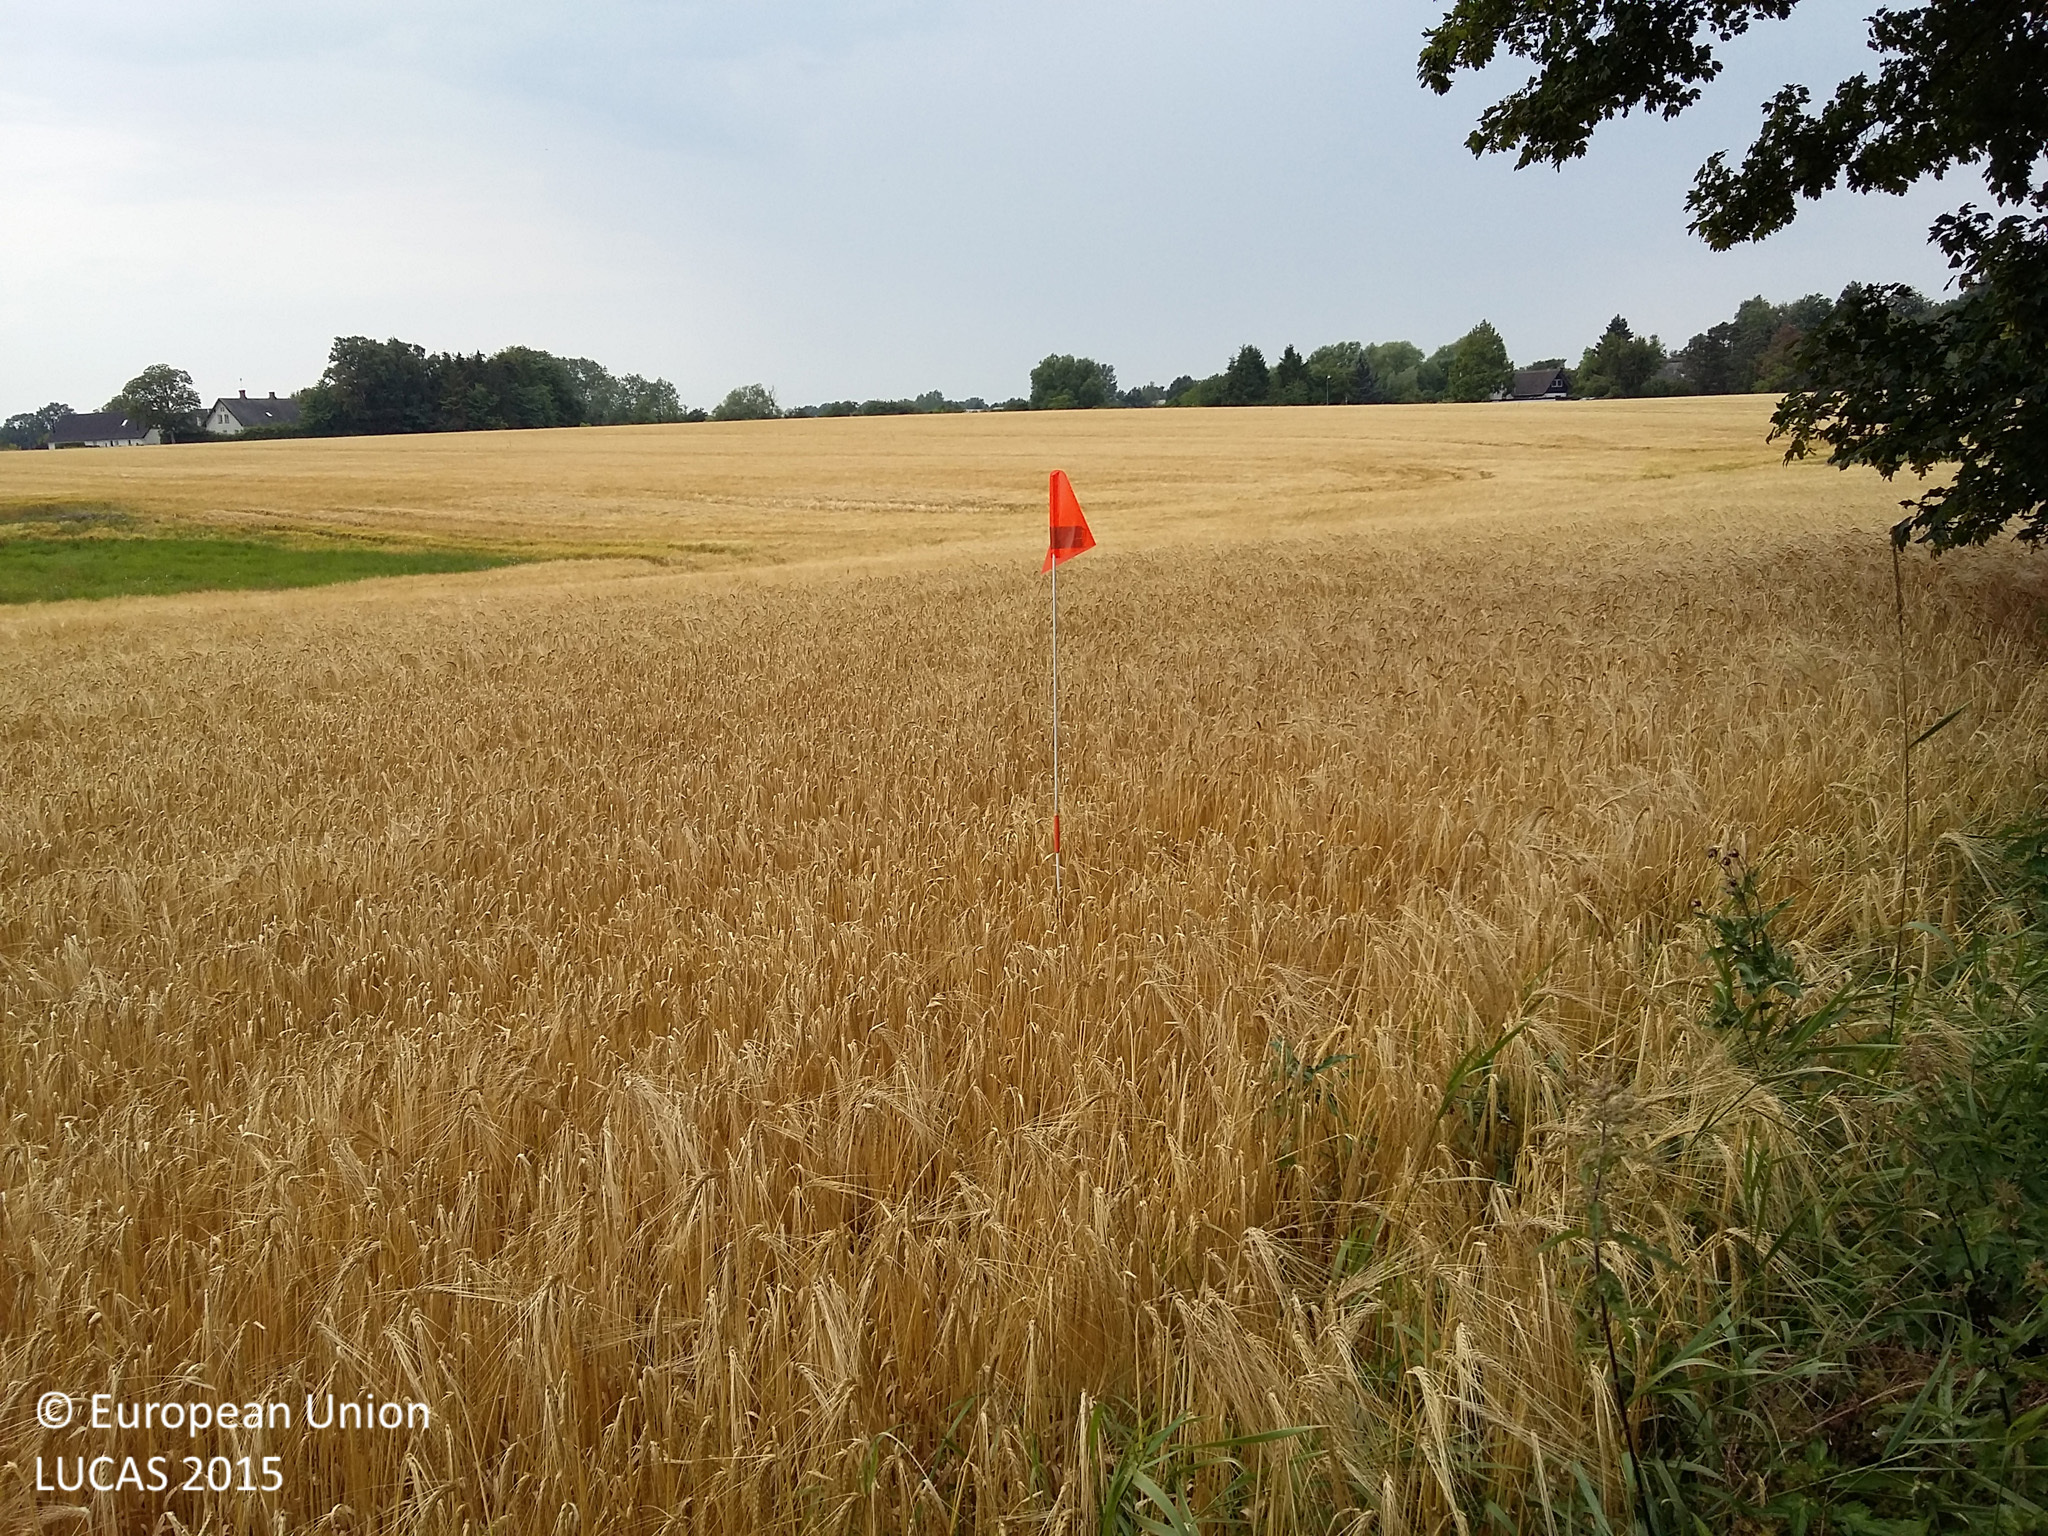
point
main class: Cropland
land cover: Barley
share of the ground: > 75 %
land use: Agriculture (excluding fallow land and kitchen gardens)
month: August
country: DK
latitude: 55.4143
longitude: 12.1624
